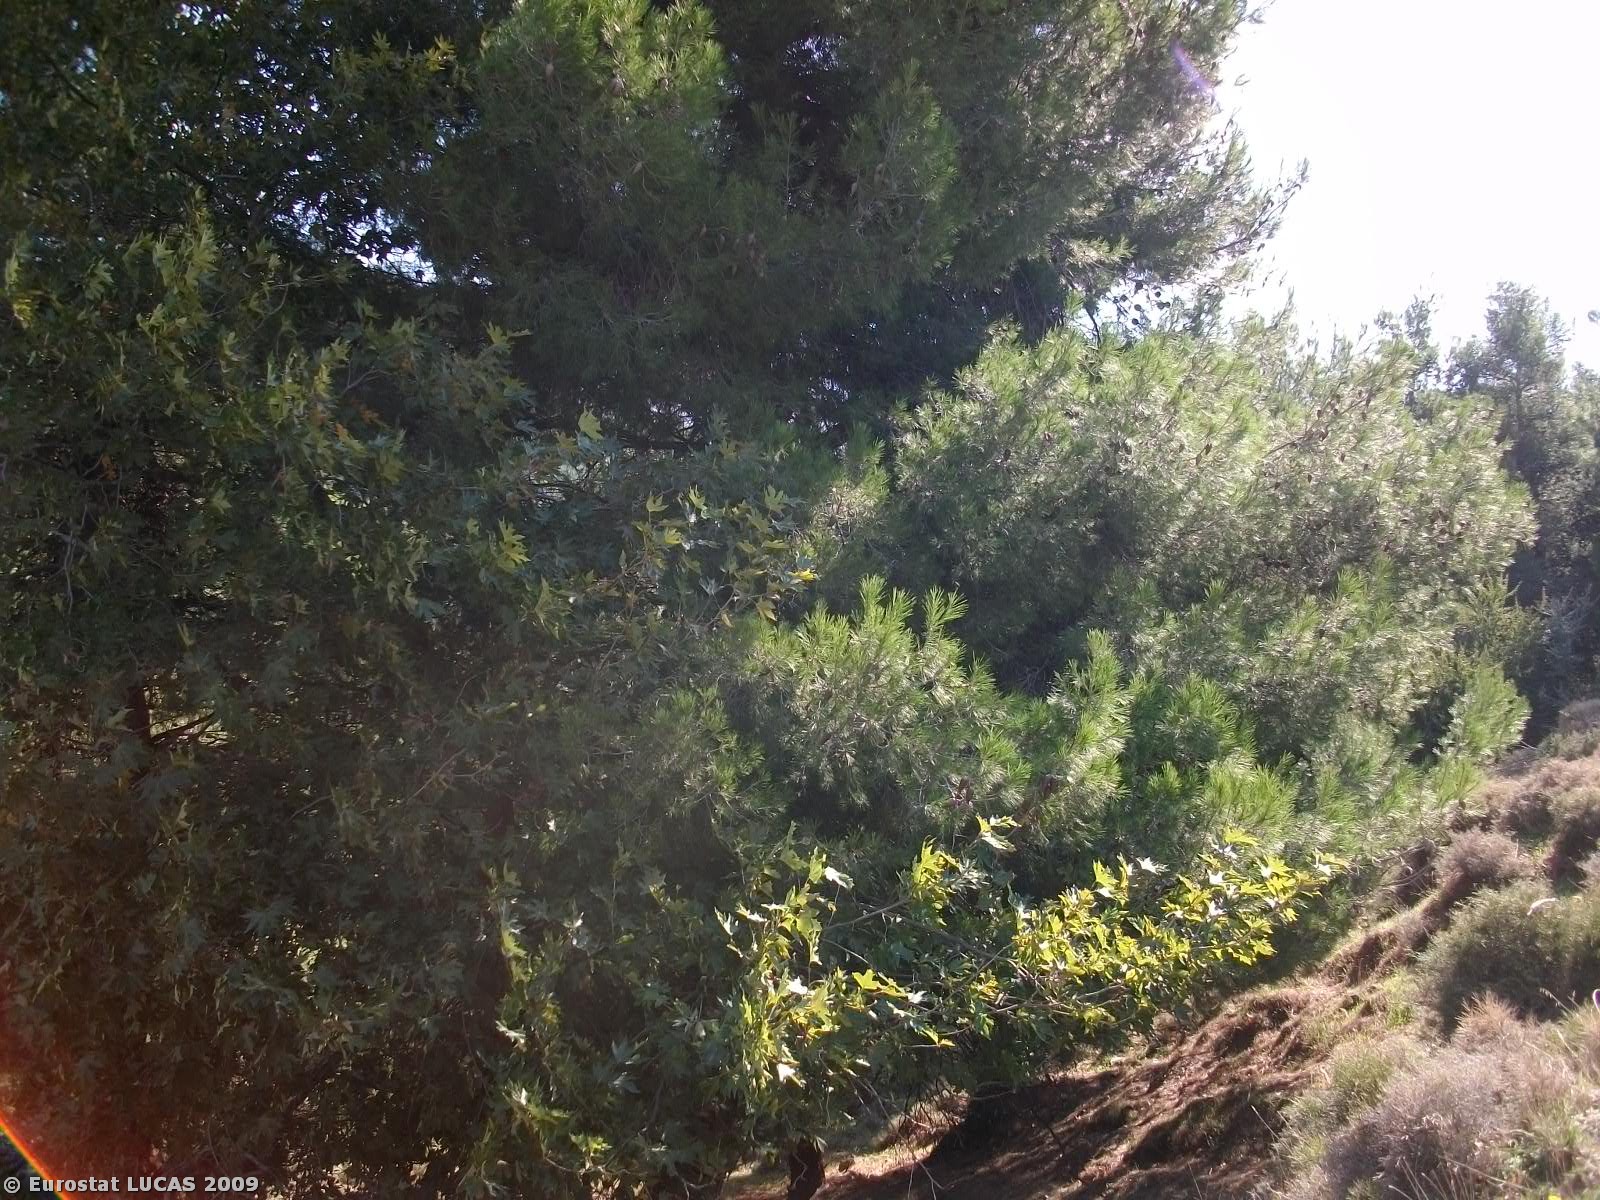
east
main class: Shrubland
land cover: Shrubland with sparse tree cover
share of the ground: > 75 %
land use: Unused
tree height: < 5 m
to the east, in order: Shrubland with sparse tree cover; Rivers and streams; Coniferous woodland
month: October
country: GR
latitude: 38.5446
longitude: 23.8617
